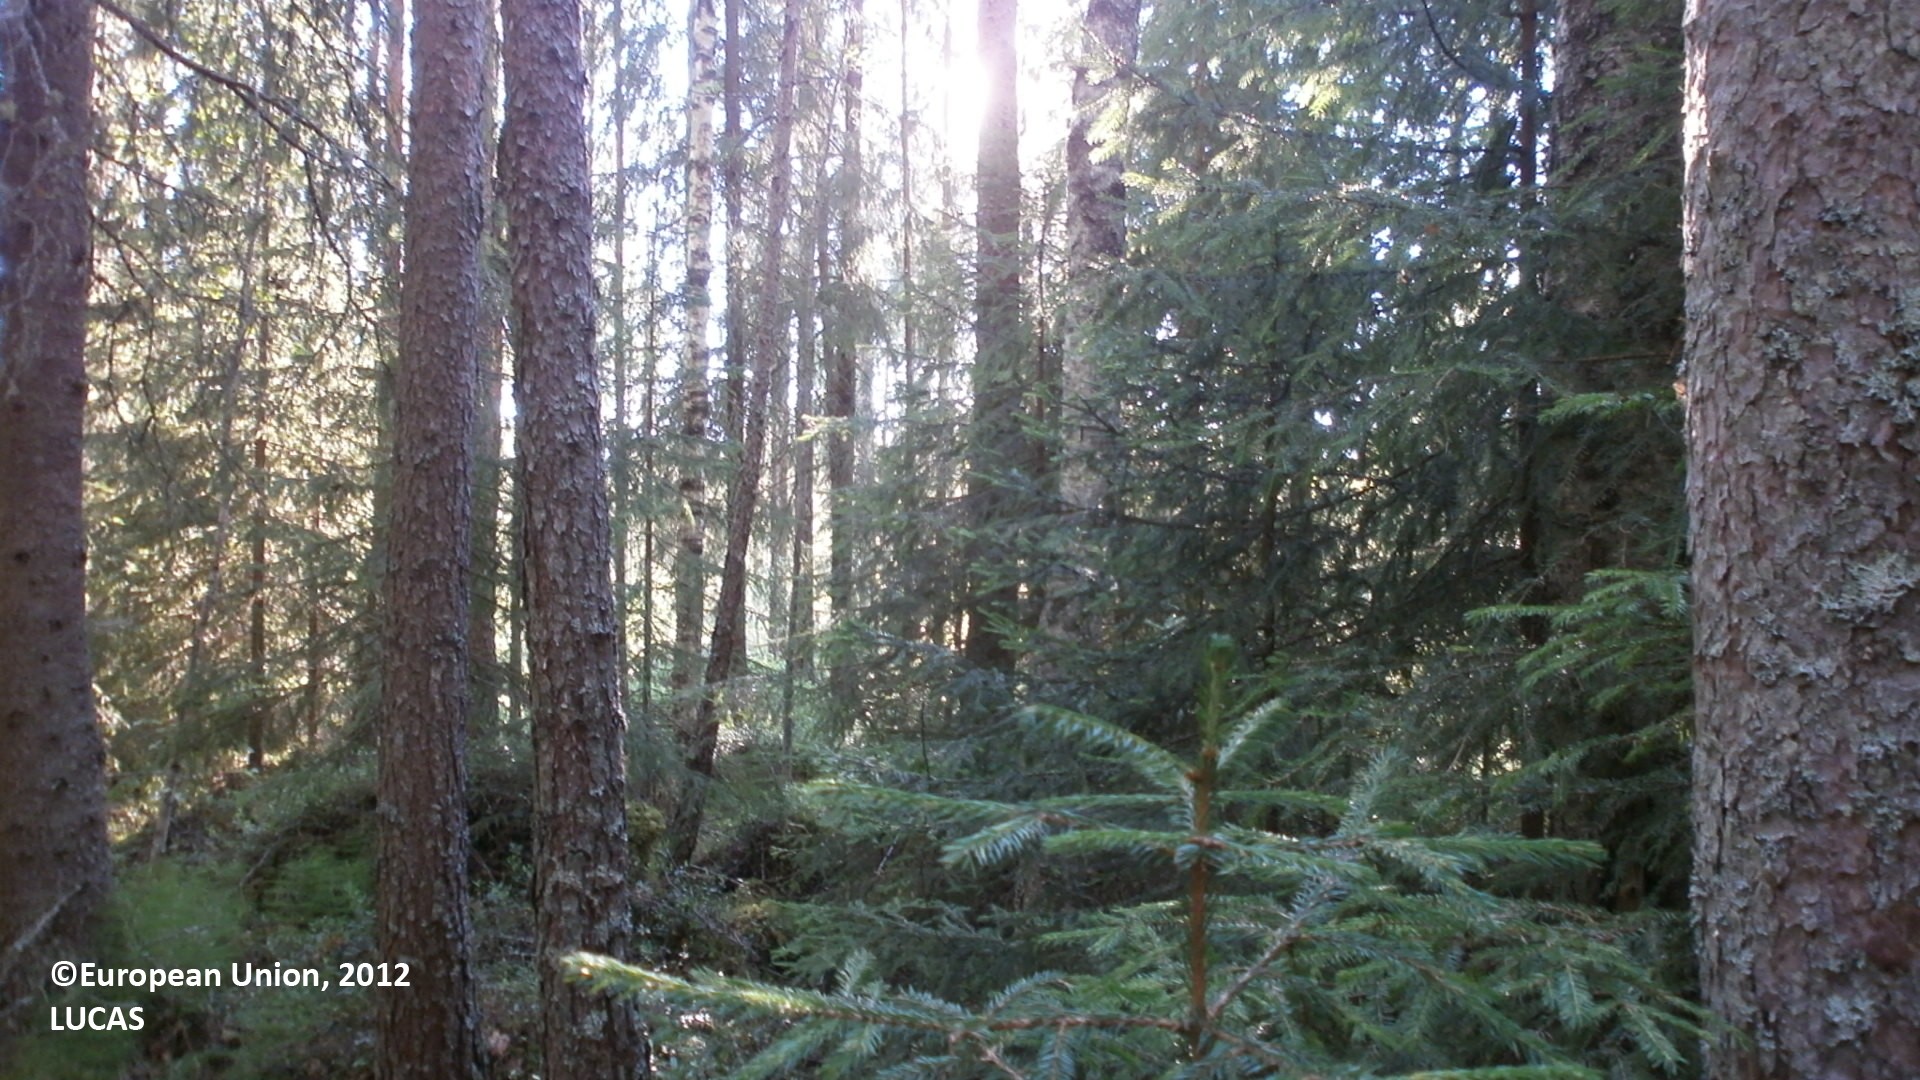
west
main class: Woodland
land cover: Spruce dominated mixed woodland
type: boreal forest
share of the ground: > 75 %
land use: Forestry
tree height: > 5 m
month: July
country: FI
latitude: 64.1541
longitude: 24.0657
